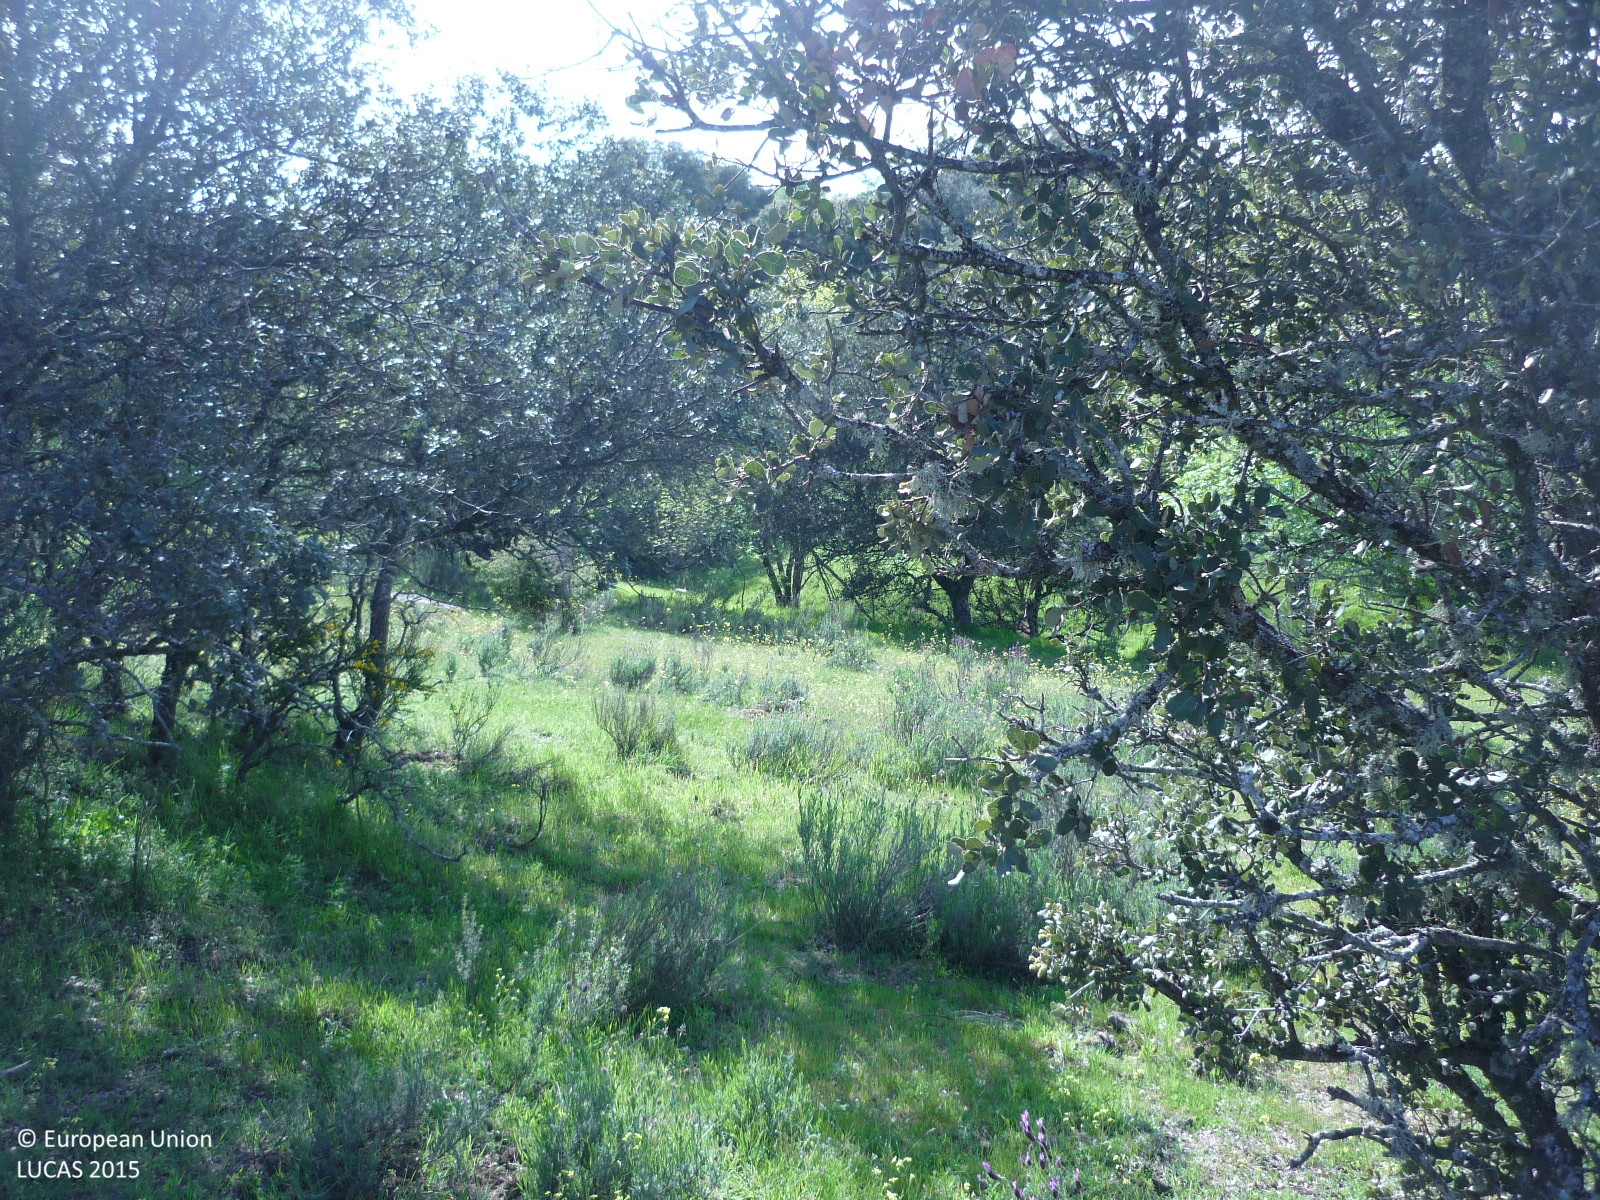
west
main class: Woodland
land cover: Broadleaved woodland
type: broadleaved evergreen forest
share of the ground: 50 - 75 %
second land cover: Grassland without tree/shrub cover
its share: > 75 %
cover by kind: broadleaved forest trees 60 %, herbaceous plants 30 %, shrubs 10 %
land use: Forestry
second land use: Agriculture (excluding fallow land and kitchen gardens)
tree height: > 5 m
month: April
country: ES
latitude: 40.7374
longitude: -3.6469
